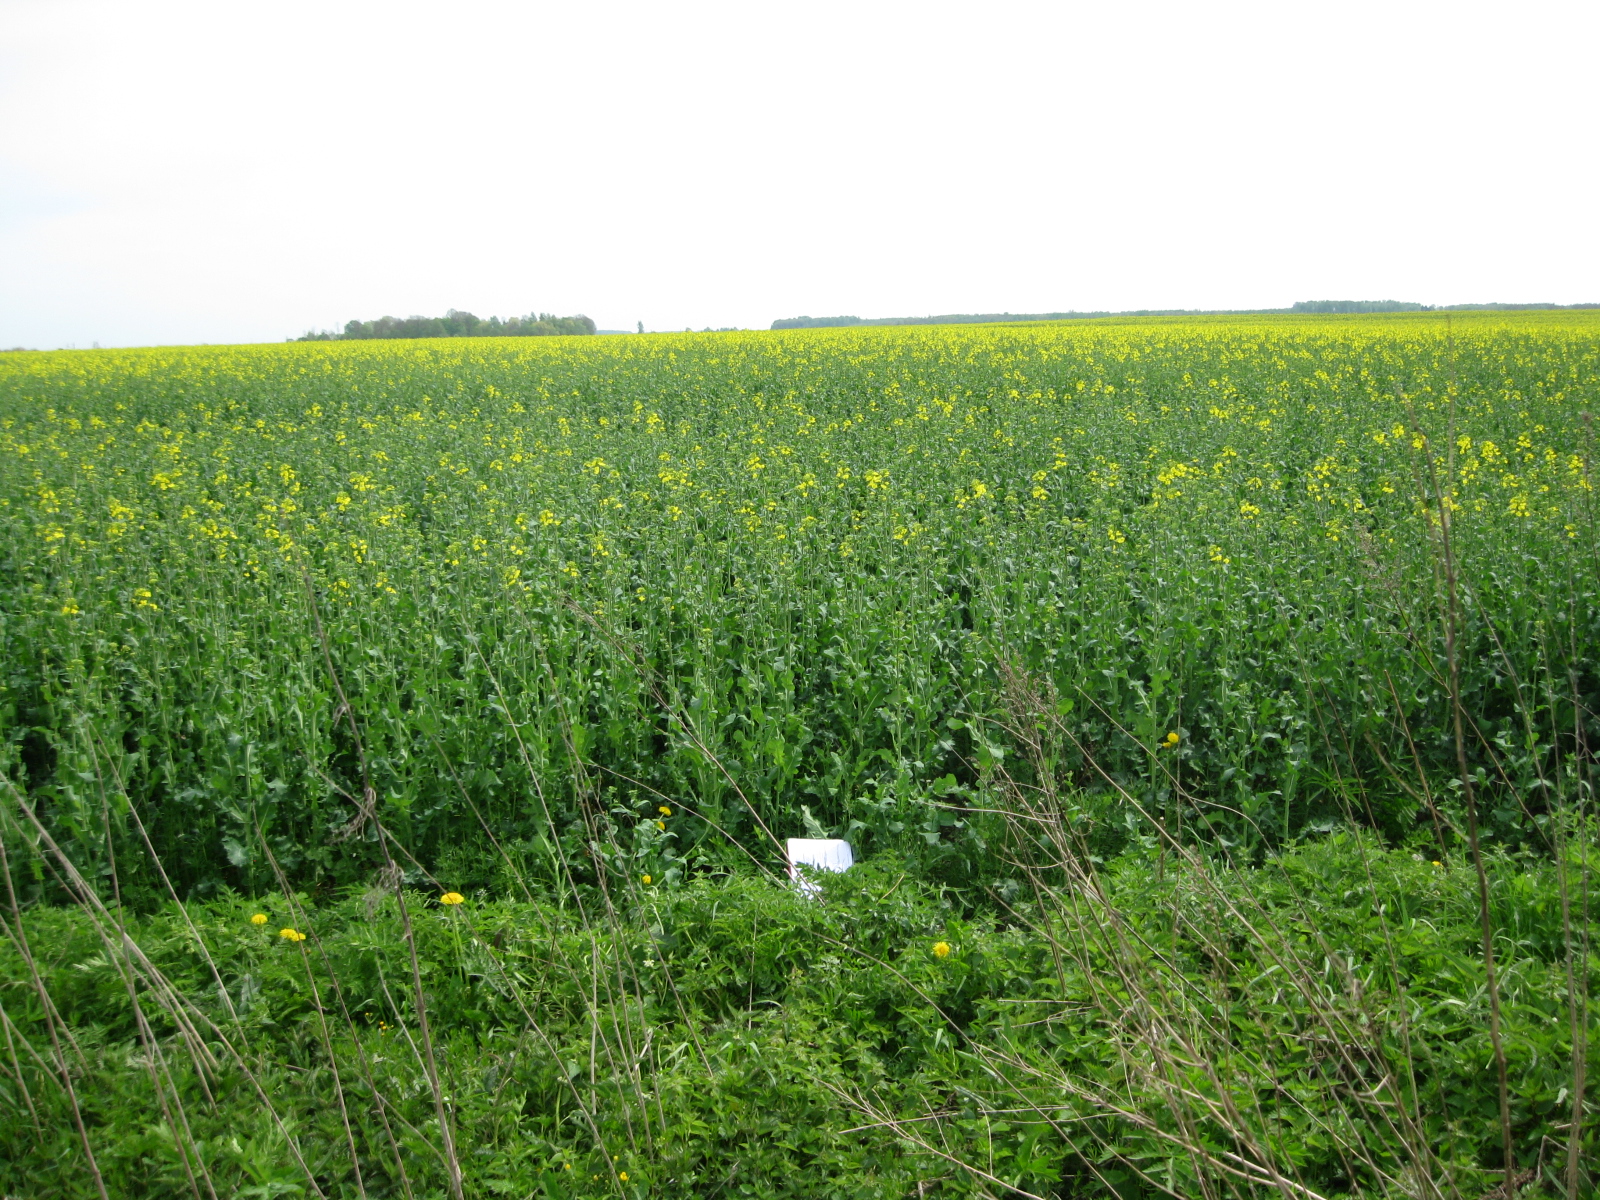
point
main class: Grassland
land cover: Spontaneously vegetated surfaces
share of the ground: > 75 %
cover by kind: herbaceous plants 100 %
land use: Fallow land
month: May
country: LT
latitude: 56.2963
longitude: 24.2959
